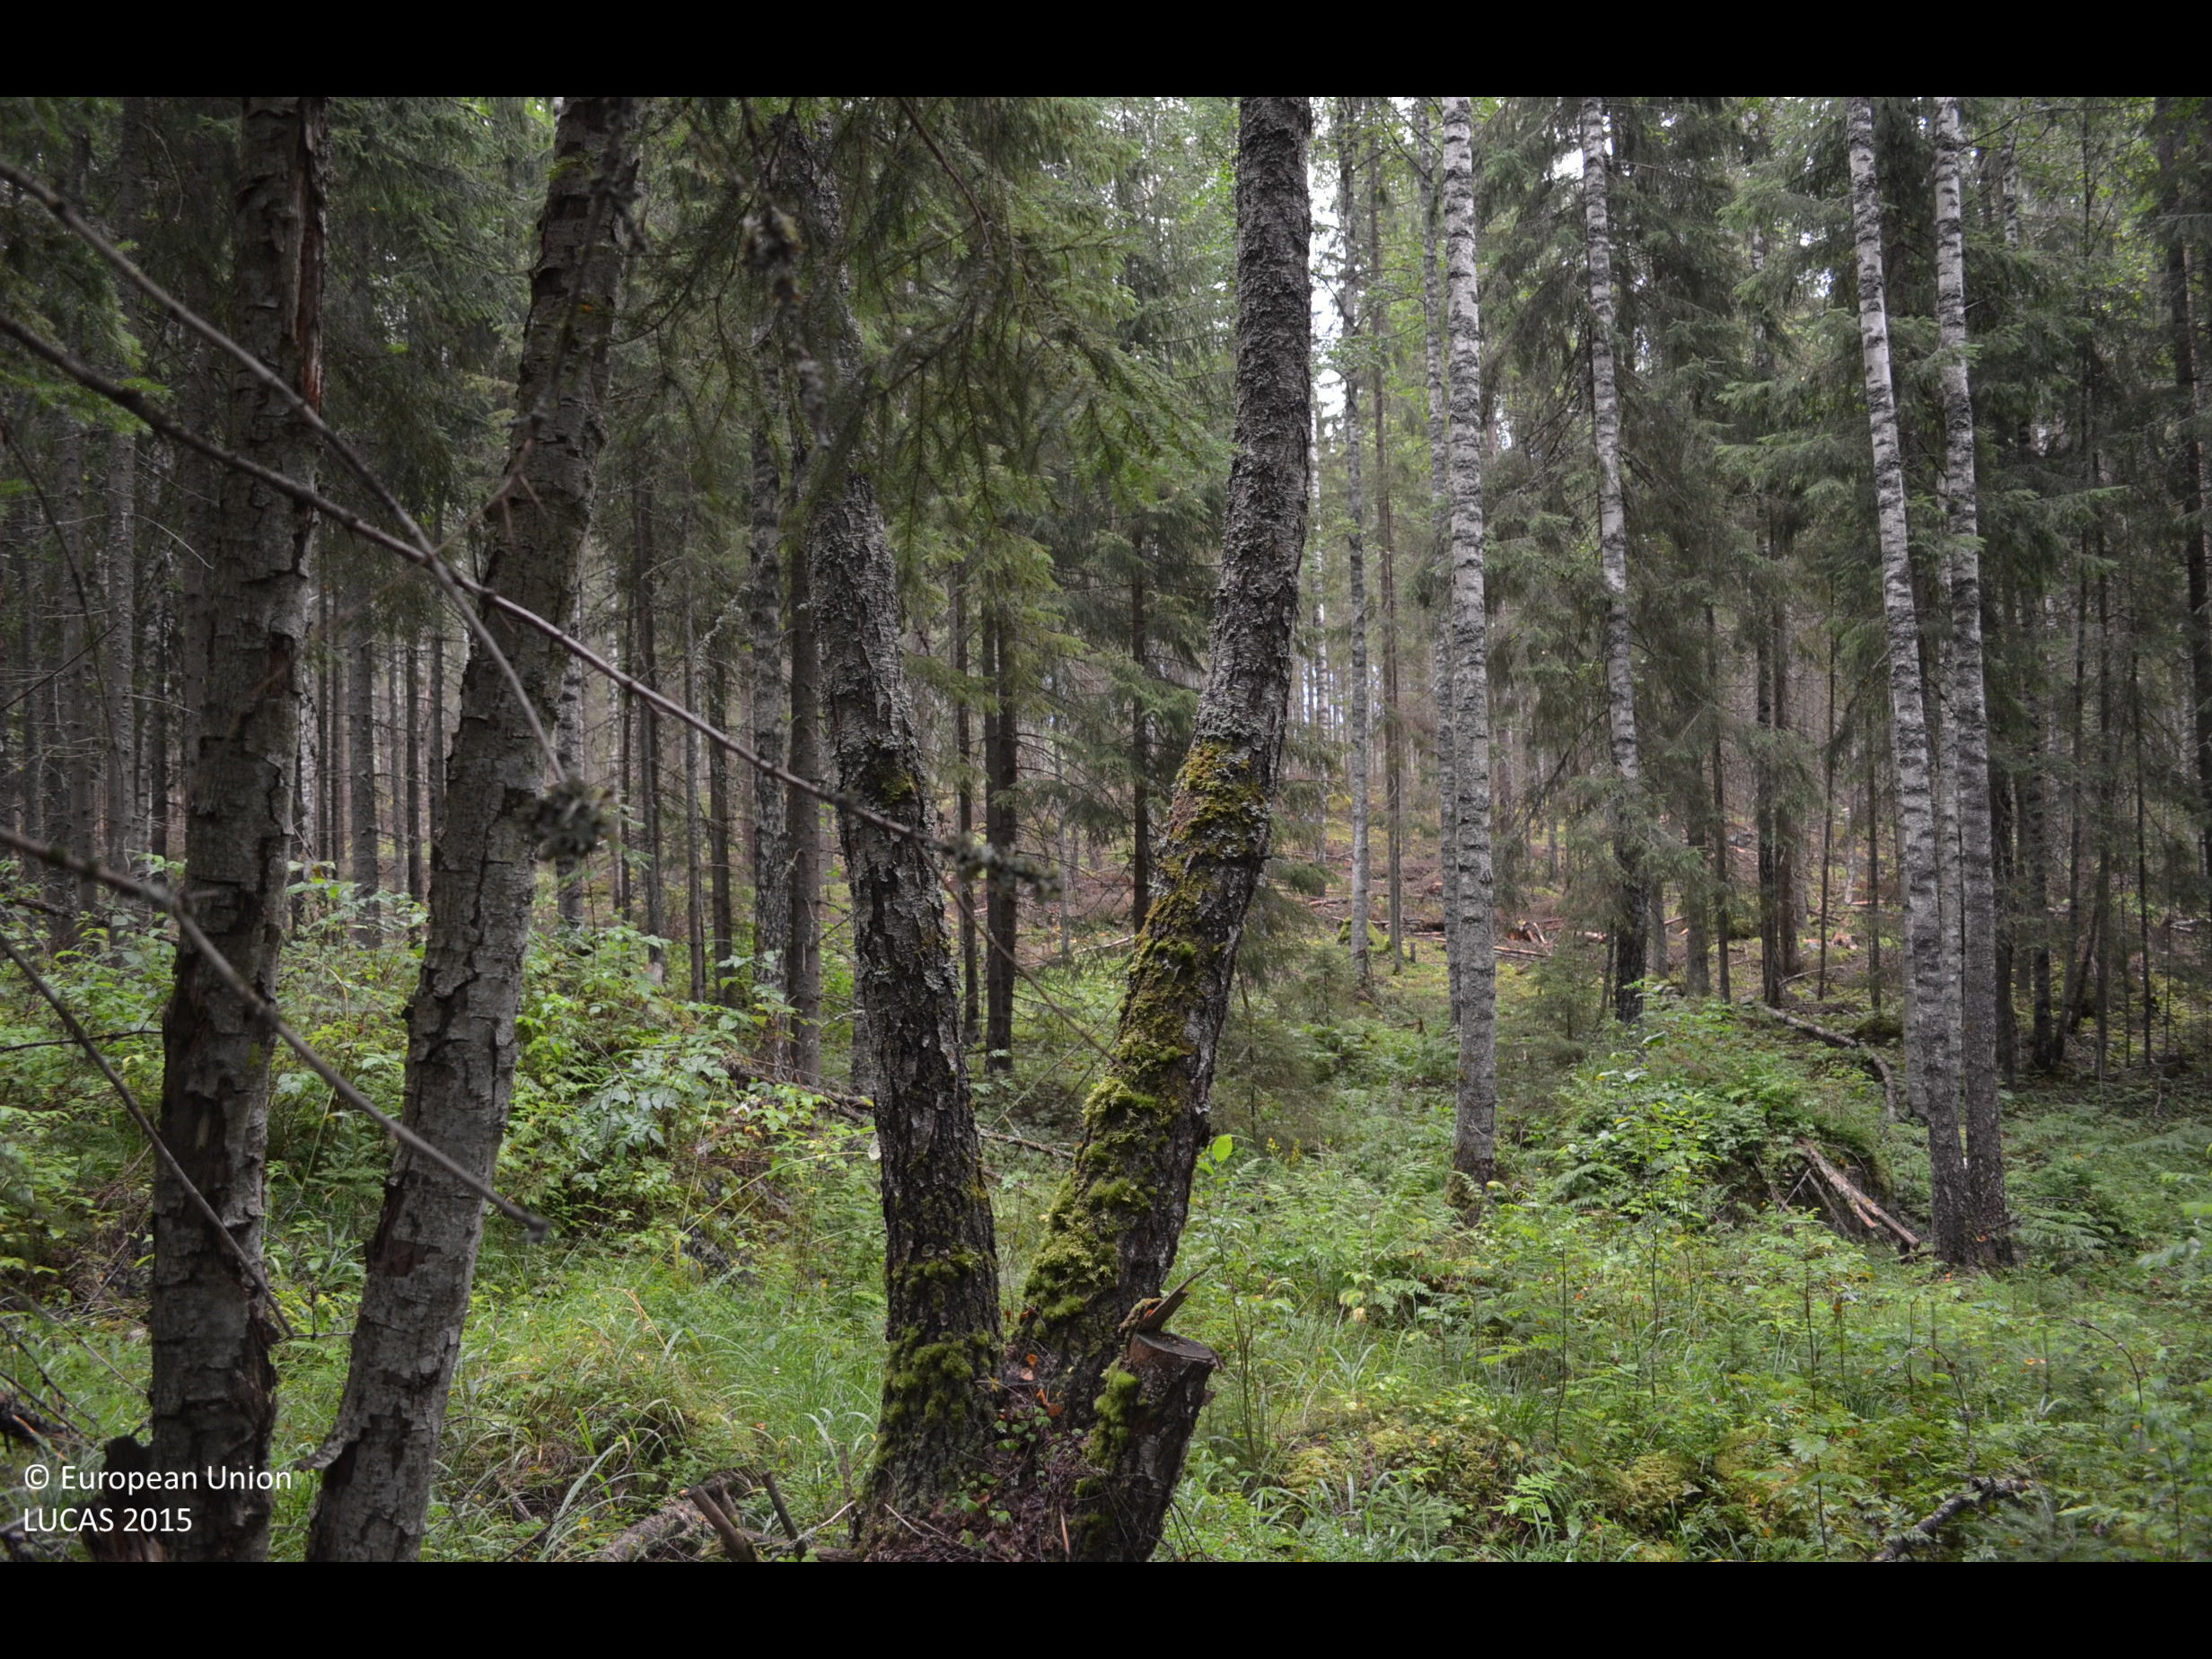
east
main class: Woodland
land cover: Spruce dominated mixed woodland
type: boreal forest
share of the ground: 50 - 75 %
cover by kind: broadleaved forest trees 40 %, coniferous forest trees 30 %, herbaceous plants 25 %, shrubs 5 %
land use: Forestry
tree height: > 5 m
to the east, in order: Spruce dominated mixed woodland; Shrubland with sparse tree cover
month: August
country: FI
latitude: 61.5382
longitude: 23.1459
